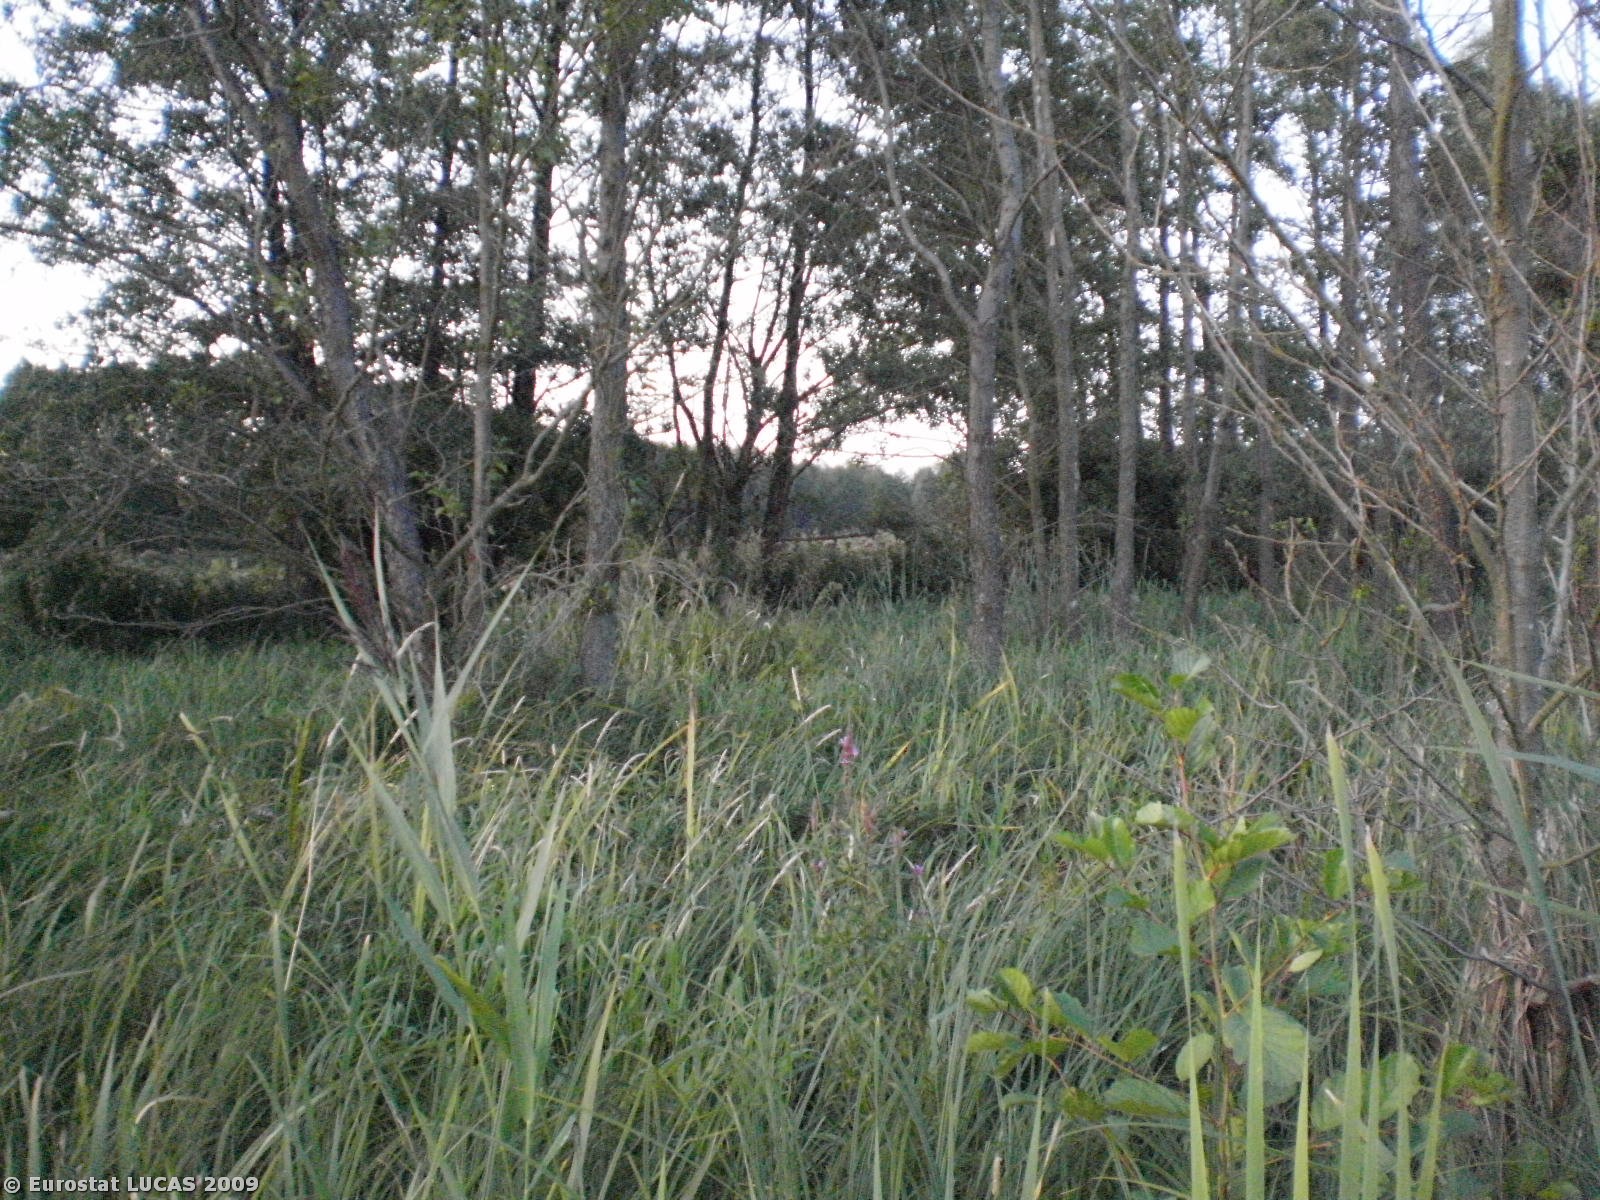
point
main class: Woodland
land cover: Broadleaved woodland
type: mire and swamp forests
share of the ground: 50 - 75 %
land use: Unused
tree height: > 5 m
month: August
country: PL
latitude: 53.3747
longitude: 21.9159
